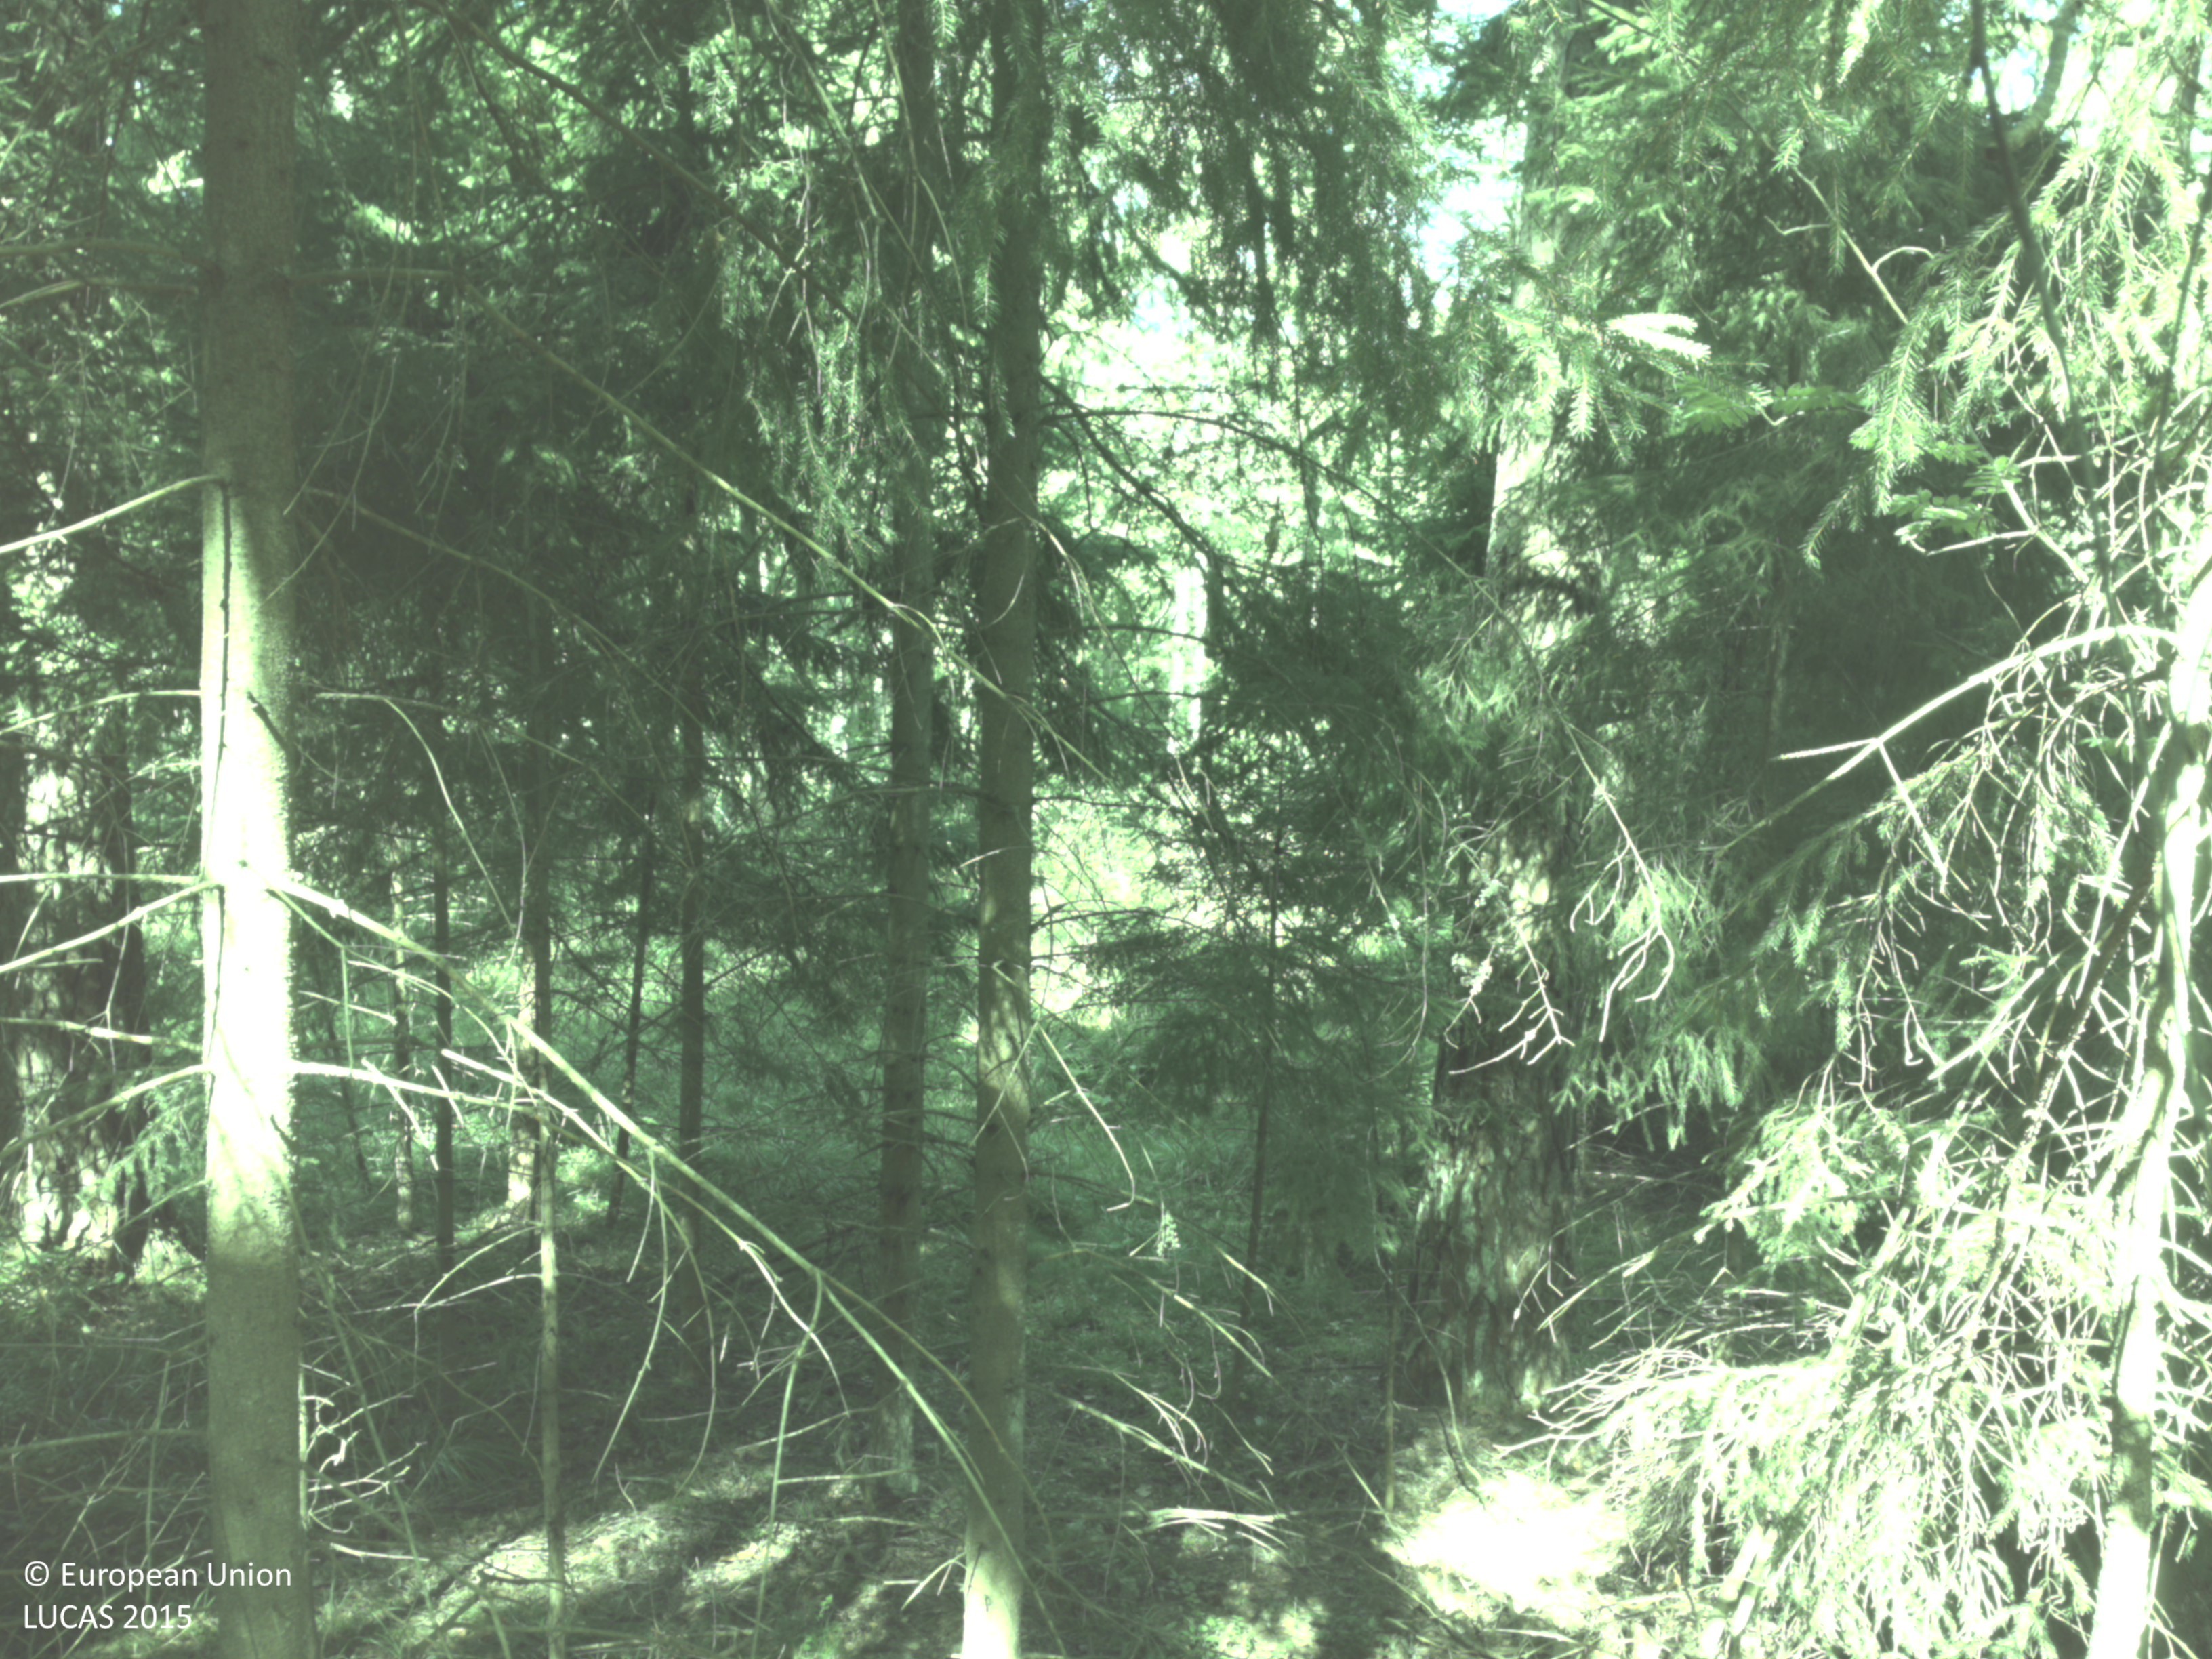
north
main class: Woodland
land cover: Pine dominated coniferous woodland
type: boreal forest
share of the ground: 50 - 75 %
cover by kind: coniferous forest trees 60 %, broadleaved forest trees 10 %, shrubs 10 %, herbaceous plants 10 %, lichens and mosses 10 %
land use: Forestry
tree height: > 5 m
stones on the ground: < 10 %
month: August
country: SE
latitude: 59.1886
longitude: 17.4354
